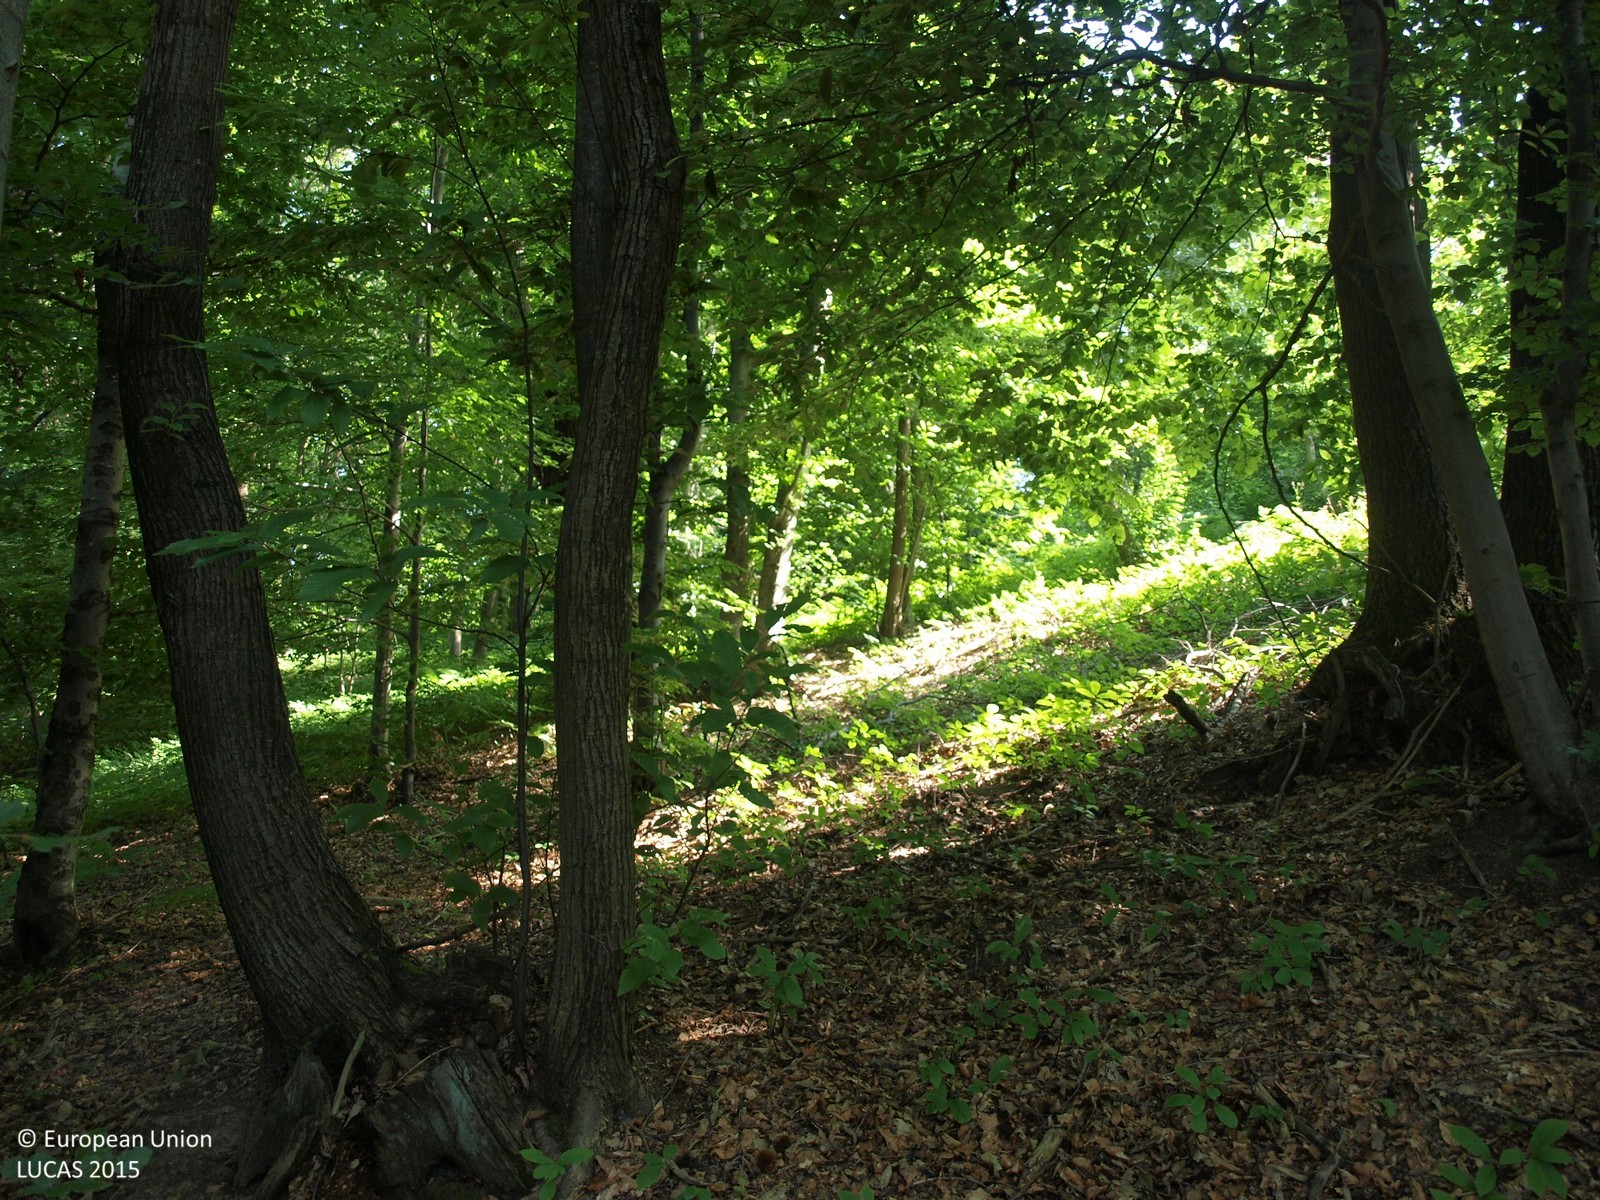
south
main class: Woodland
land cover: Broadleaved woodland
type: mesophytic deciduous forest
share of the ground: > 75 %
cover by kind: broadleaved forest trees 100 %
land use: Forestry
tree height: > 5 m
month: July
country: HR
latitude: 45.7482
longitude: 15.6916
